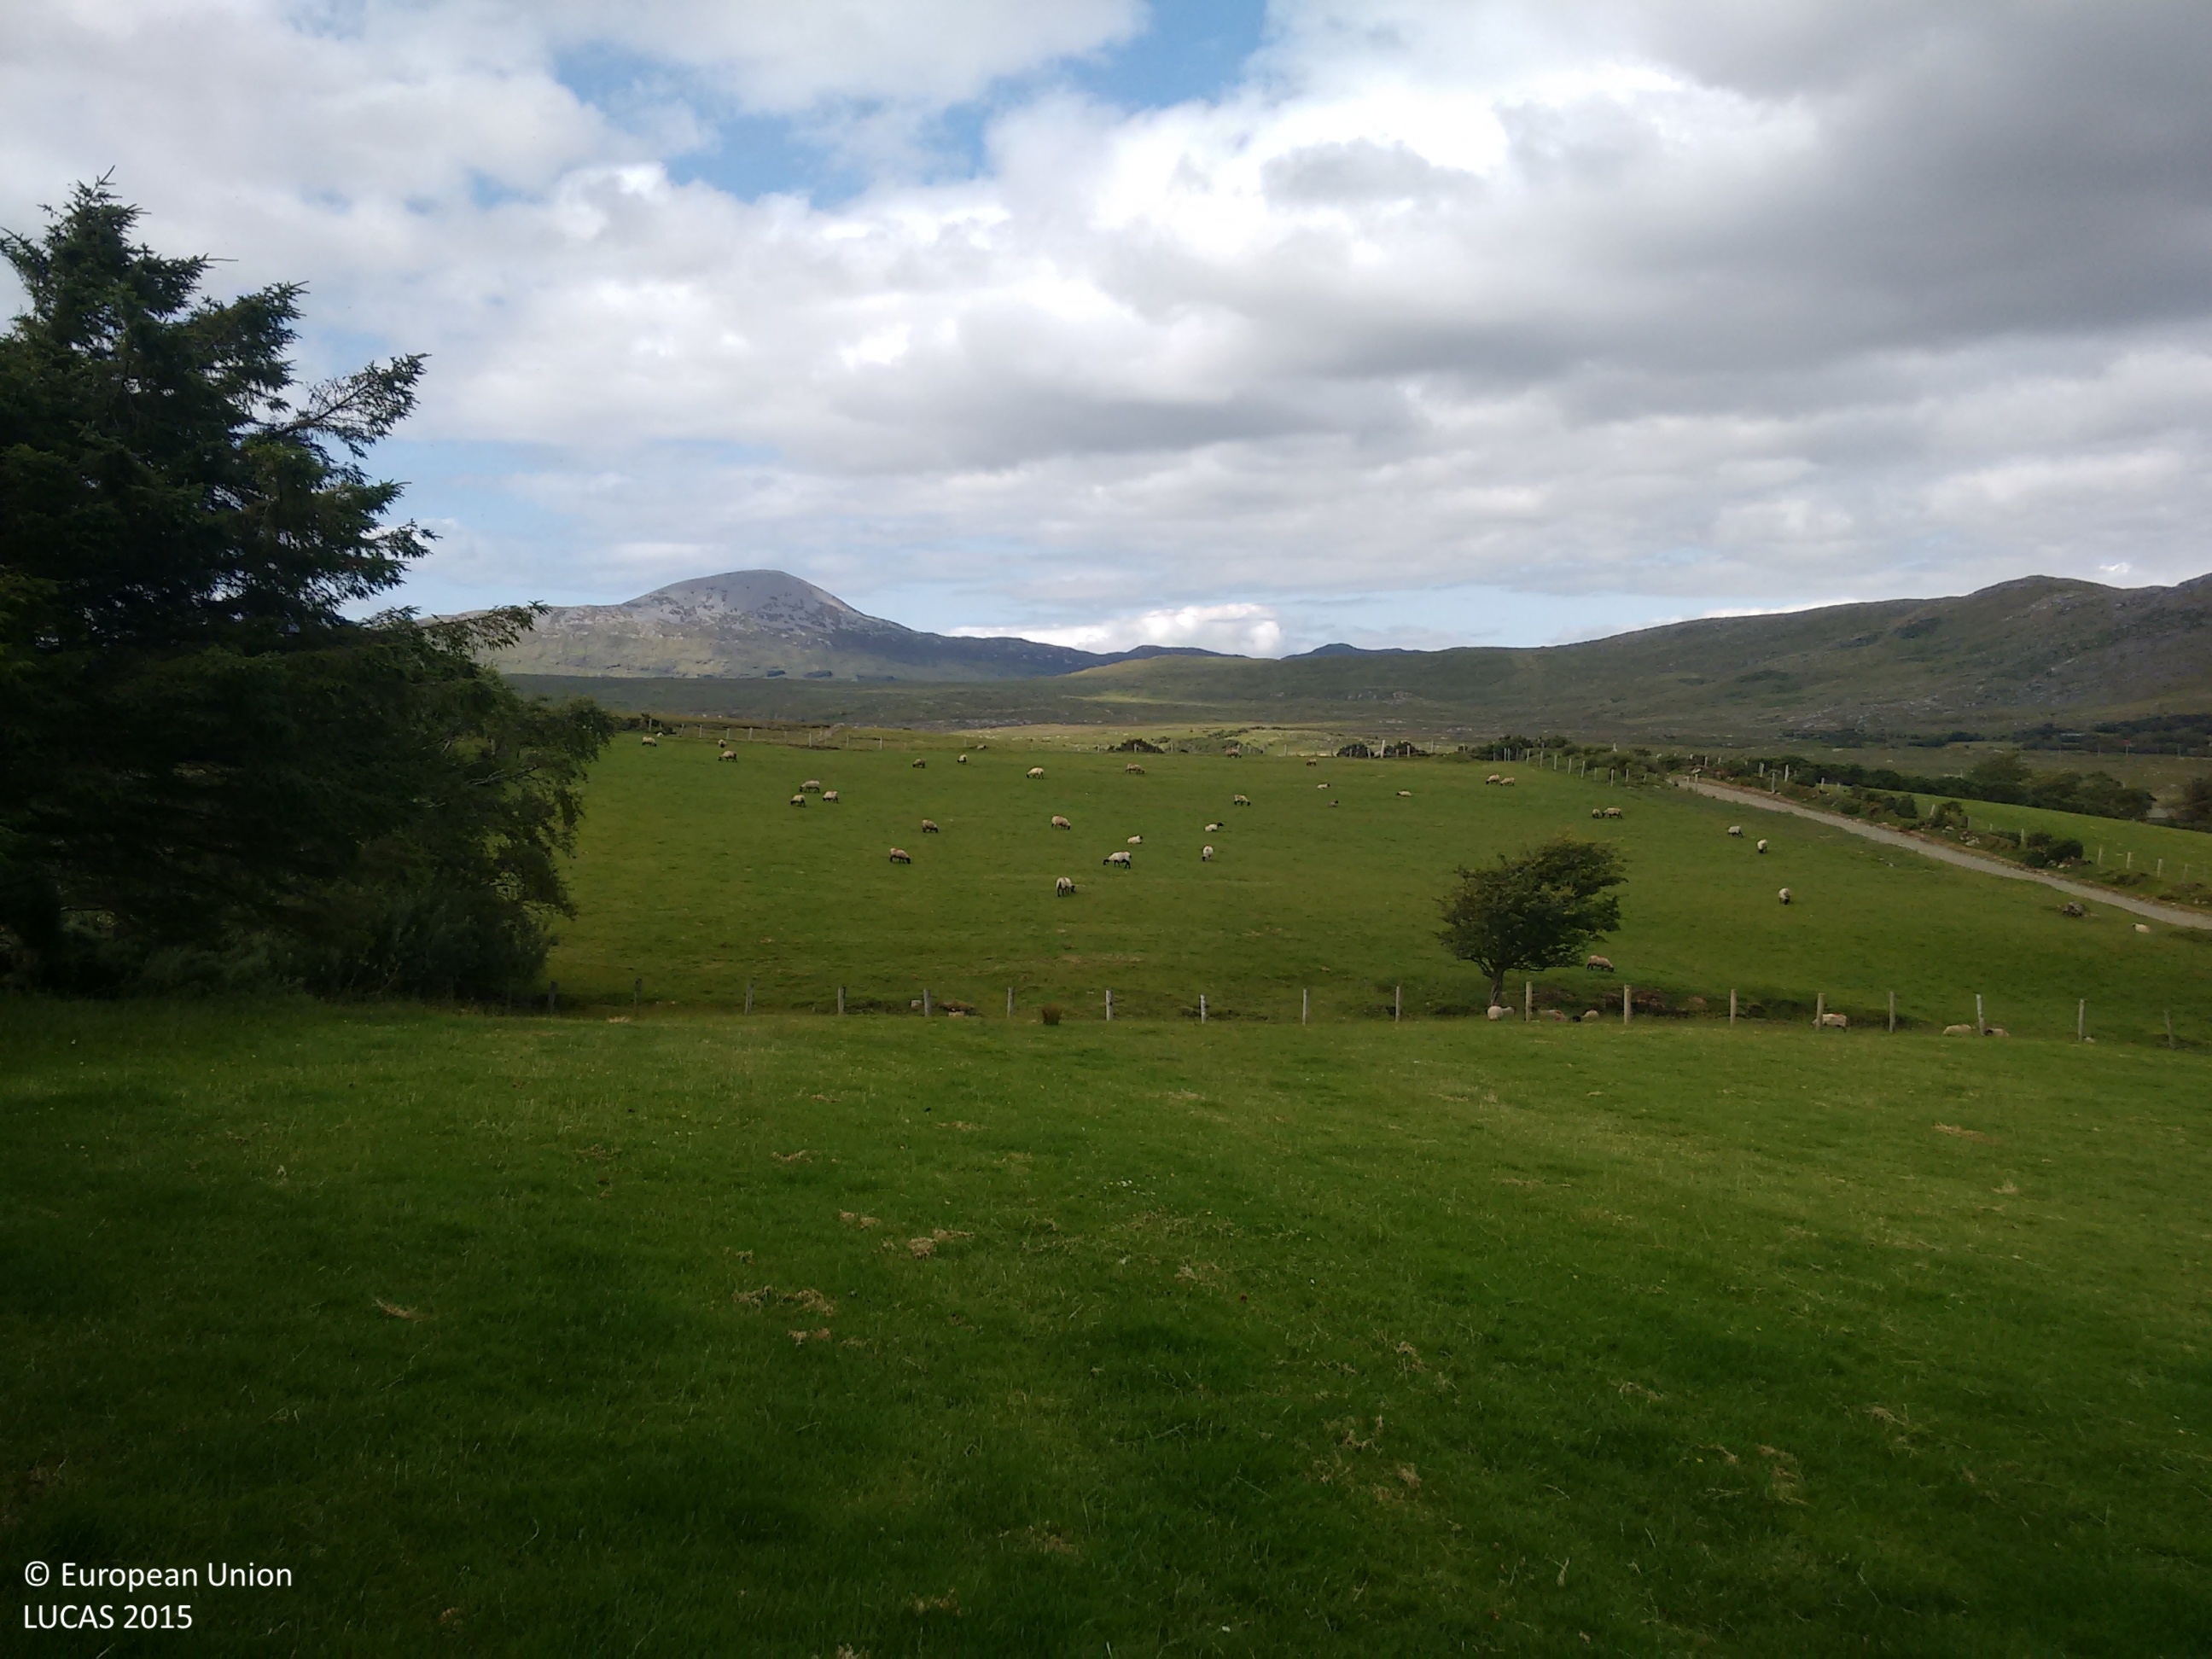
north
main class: Grassland
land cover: Grassland without tree/shrub cover
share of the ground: > 75 %
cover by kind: herbaceous plants 100 %
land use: Agriculture (excluding fallow land and kitchen gardens)
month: July
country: IE
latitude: 53.6982
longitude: -9.6405
